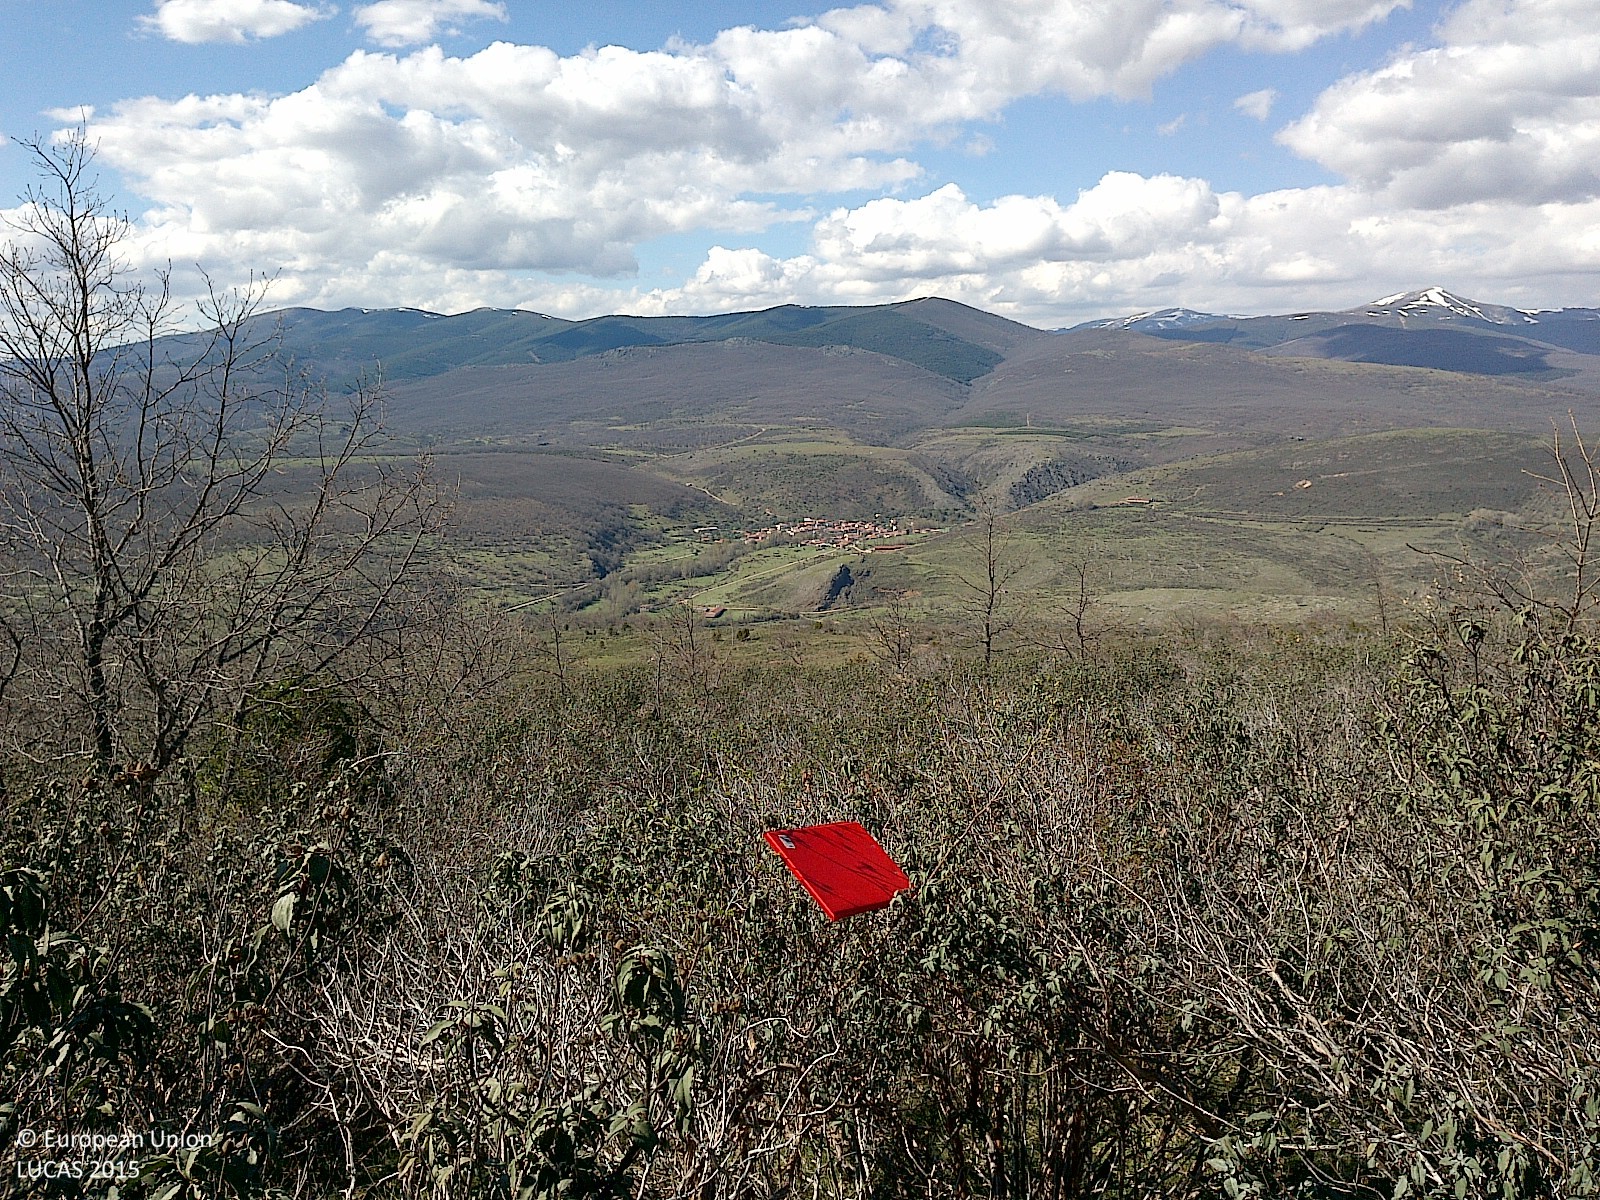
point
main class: Shrubland
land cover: Shrubland with sparse tree cover
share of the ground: > 75 %
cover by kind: shrubs 80 %, herbaceous plants 15 %, broadleaved forest trees 5 %
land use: Agriculture (excluding fallow land and kitchen gardens)
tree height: < 5 m
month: April
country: ES
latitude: 42.0943
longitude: -3.2176
